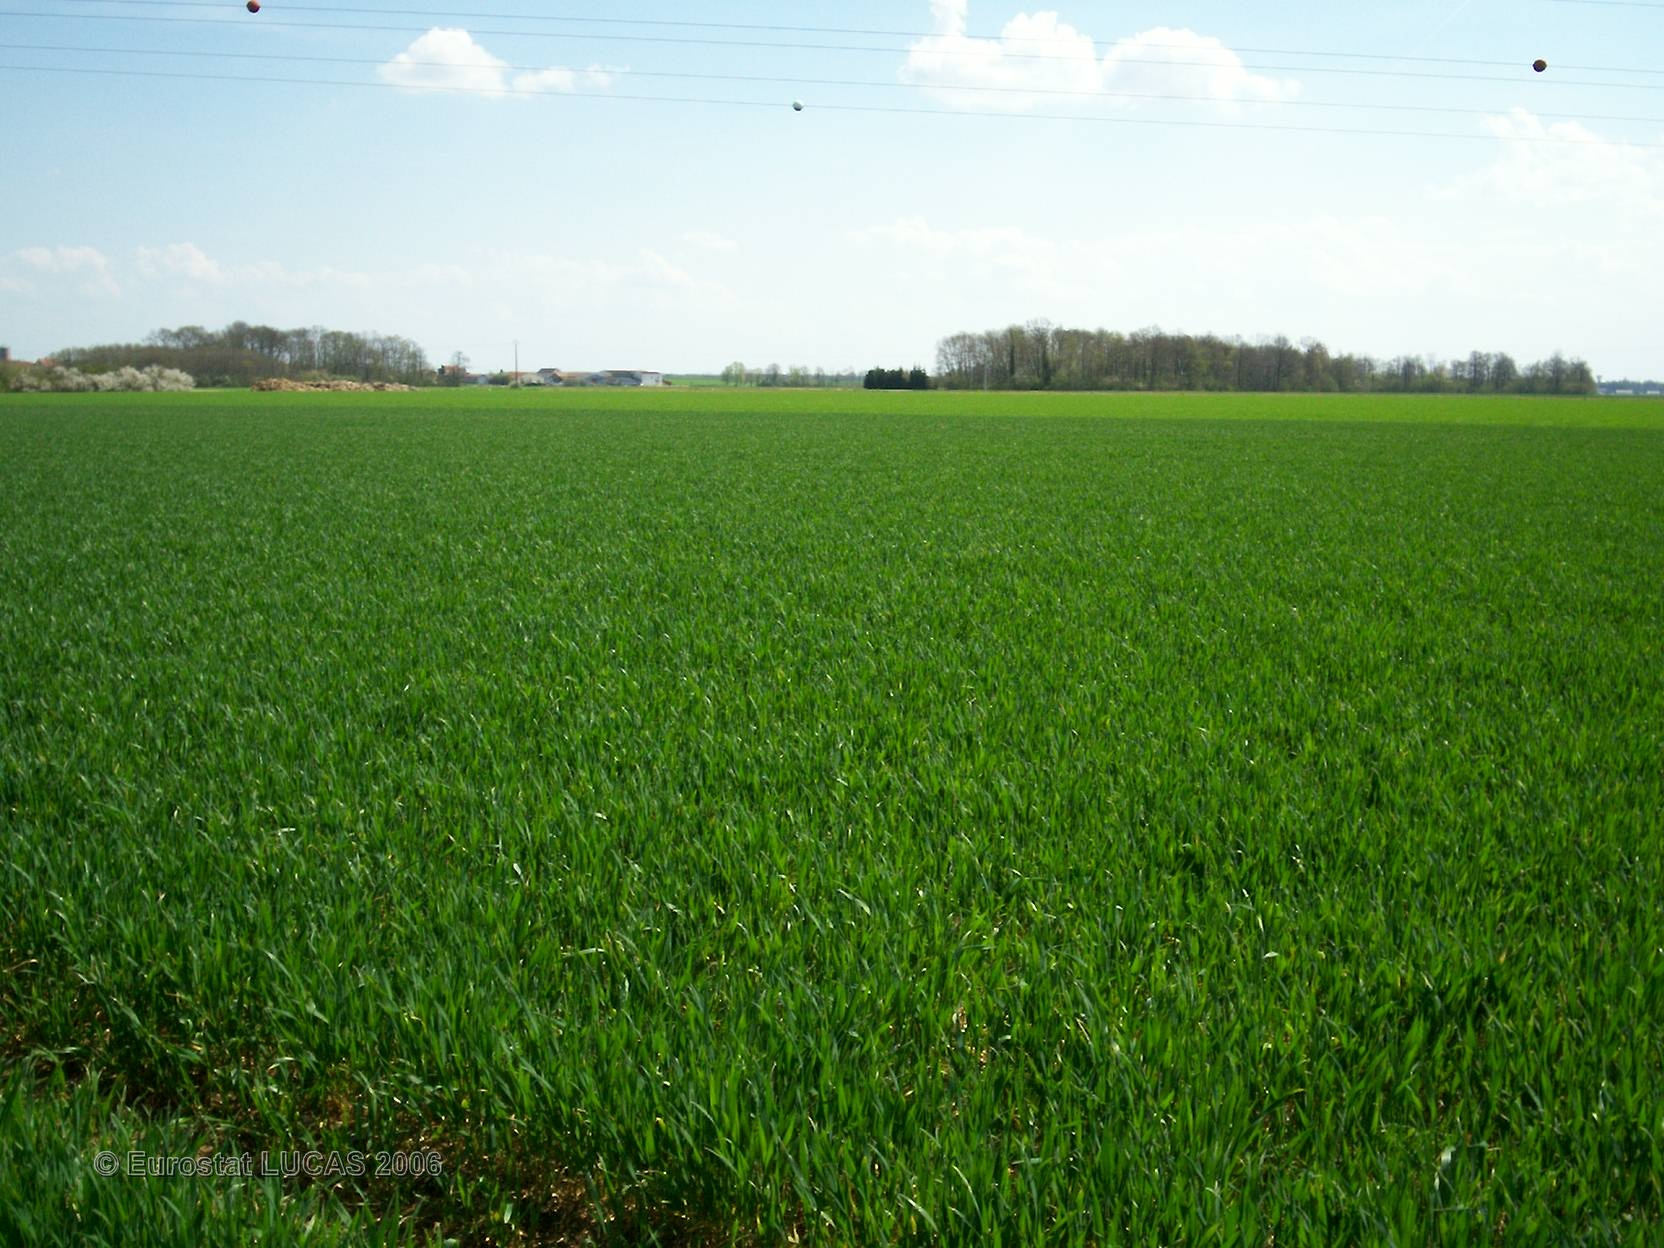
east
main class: Cropland
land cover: Common wheat
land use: Agriculture (excluding fallow land and kitchen gardens)
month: April
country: FR
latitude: 48.4301
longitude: 4.5238
